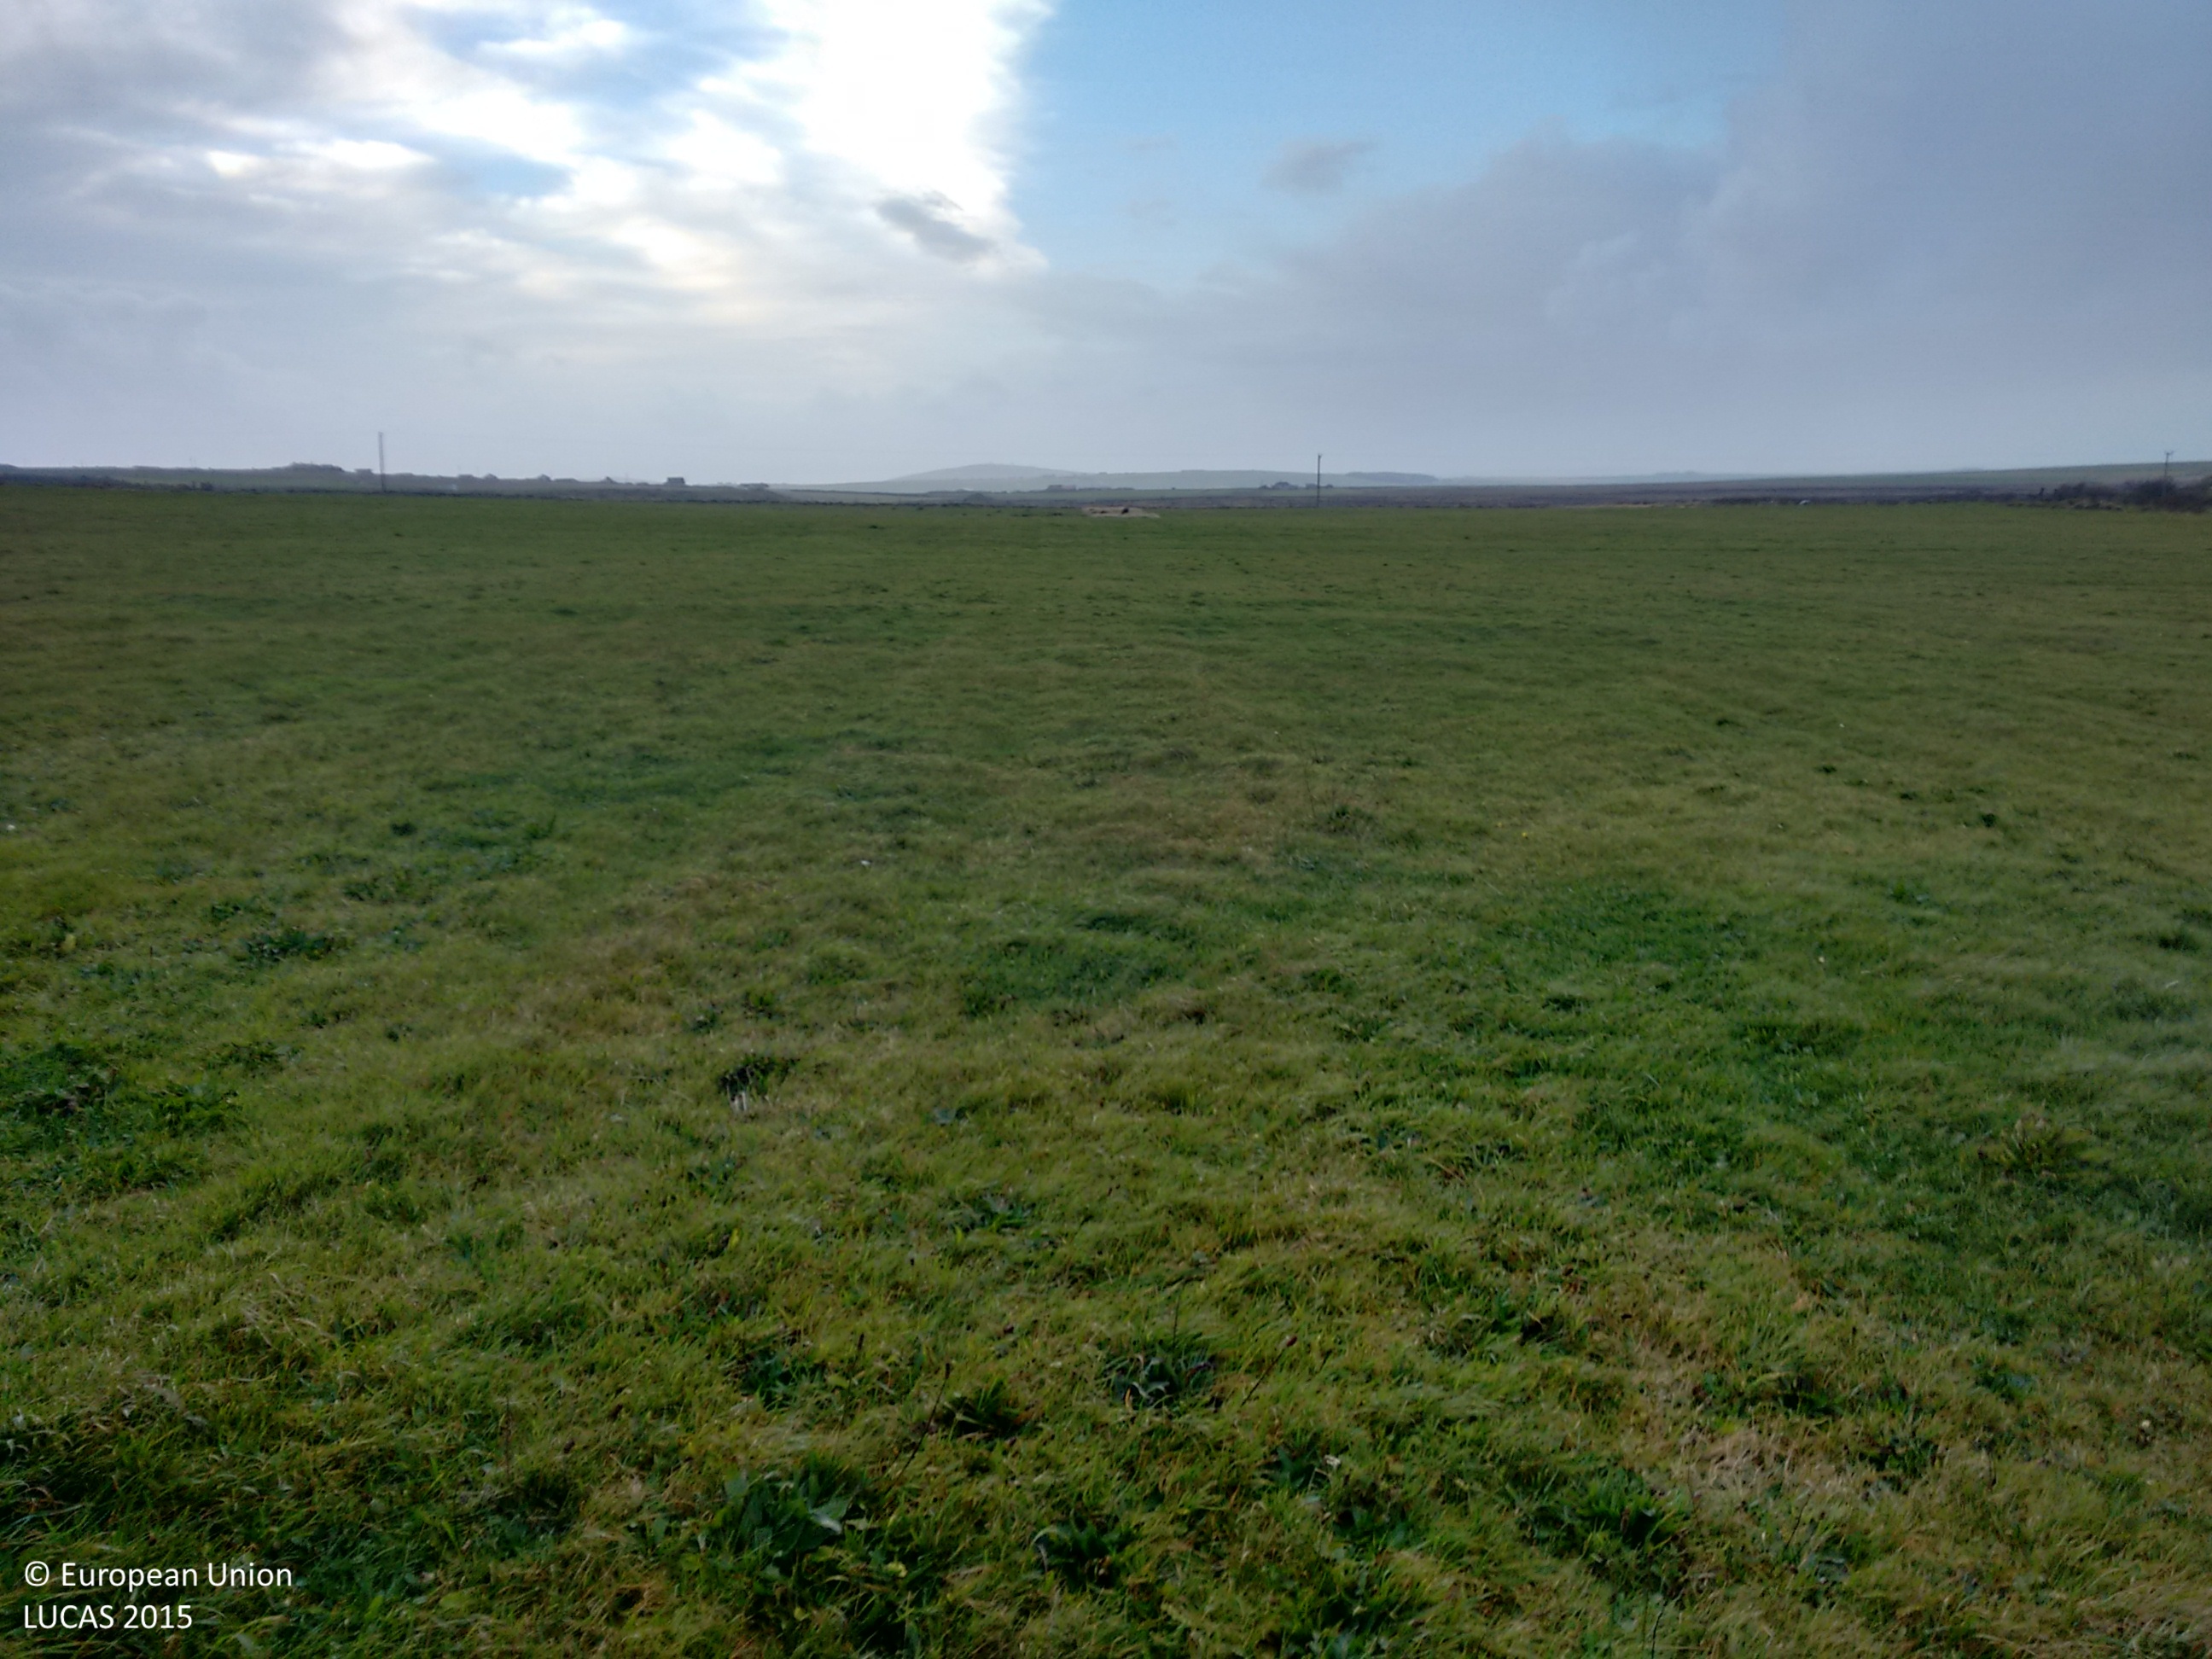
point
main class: Grassland
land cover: Grassland without tree/shrub cover
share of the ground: > 75 %
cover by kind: herbaceous plants 100 %
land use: Agriculture (excluding fallow land and kitchen gardens)
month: November
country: GB
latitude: 58.9493
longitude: -2.8608
